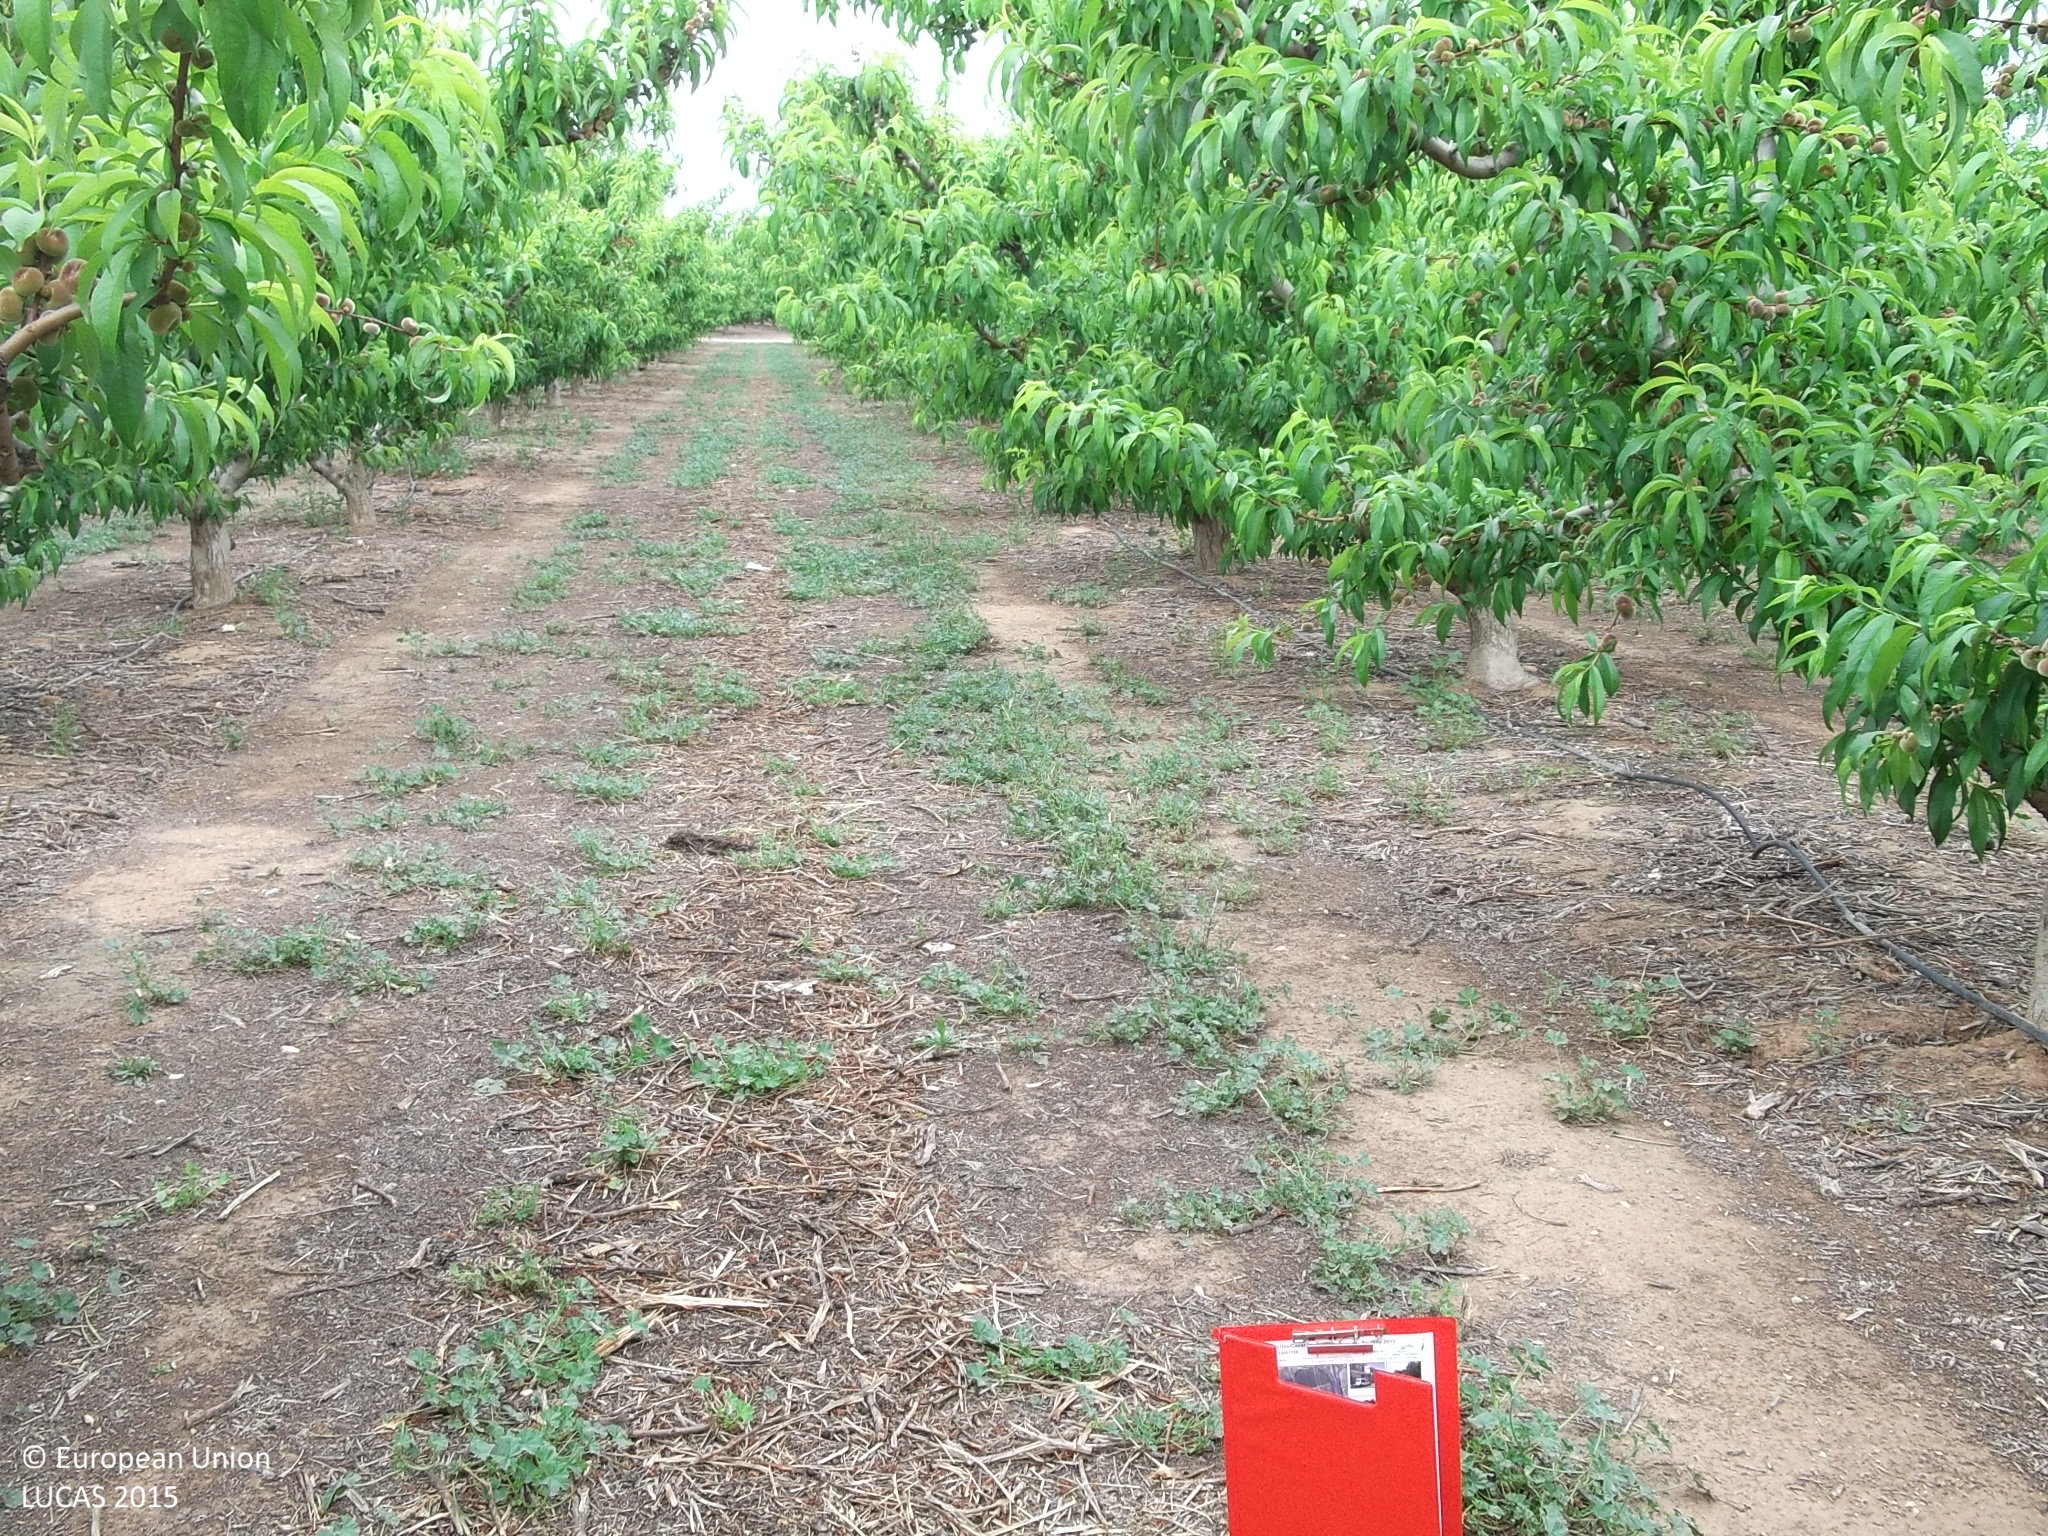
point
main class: Cropland
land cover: Other fruit trees and berries
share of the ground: 25 - 50 %
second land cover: Spontaneously vegetated surfaces
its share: 50 - 75 %
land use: Agriculture (excluding fallow land and kitchen gardens)
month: April
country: ES
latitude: 38.2204
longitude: -1.3300
